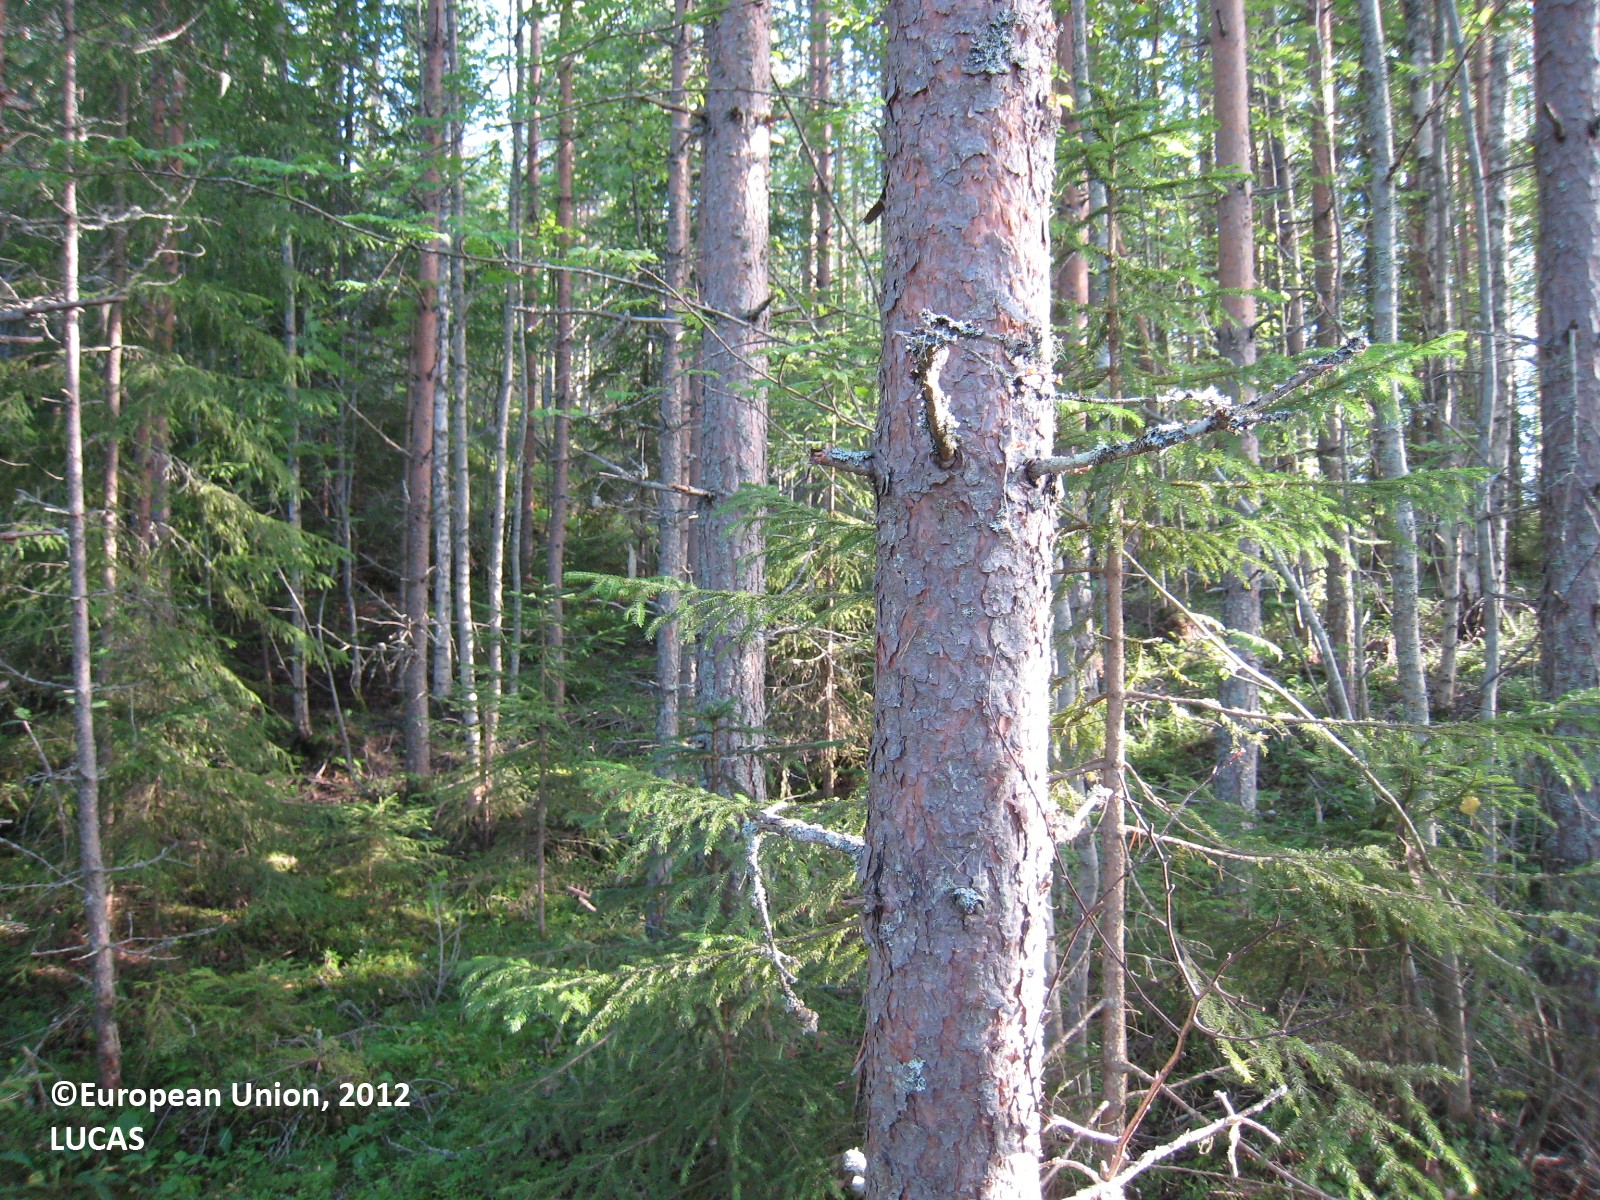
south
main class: Woodland
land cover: Pine dominated mixed woodland
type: boreal forest
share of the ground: > 75 %
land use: Forestry
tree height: > 5 m
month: July
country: FI
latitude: 62.8500
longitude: 26.7389
